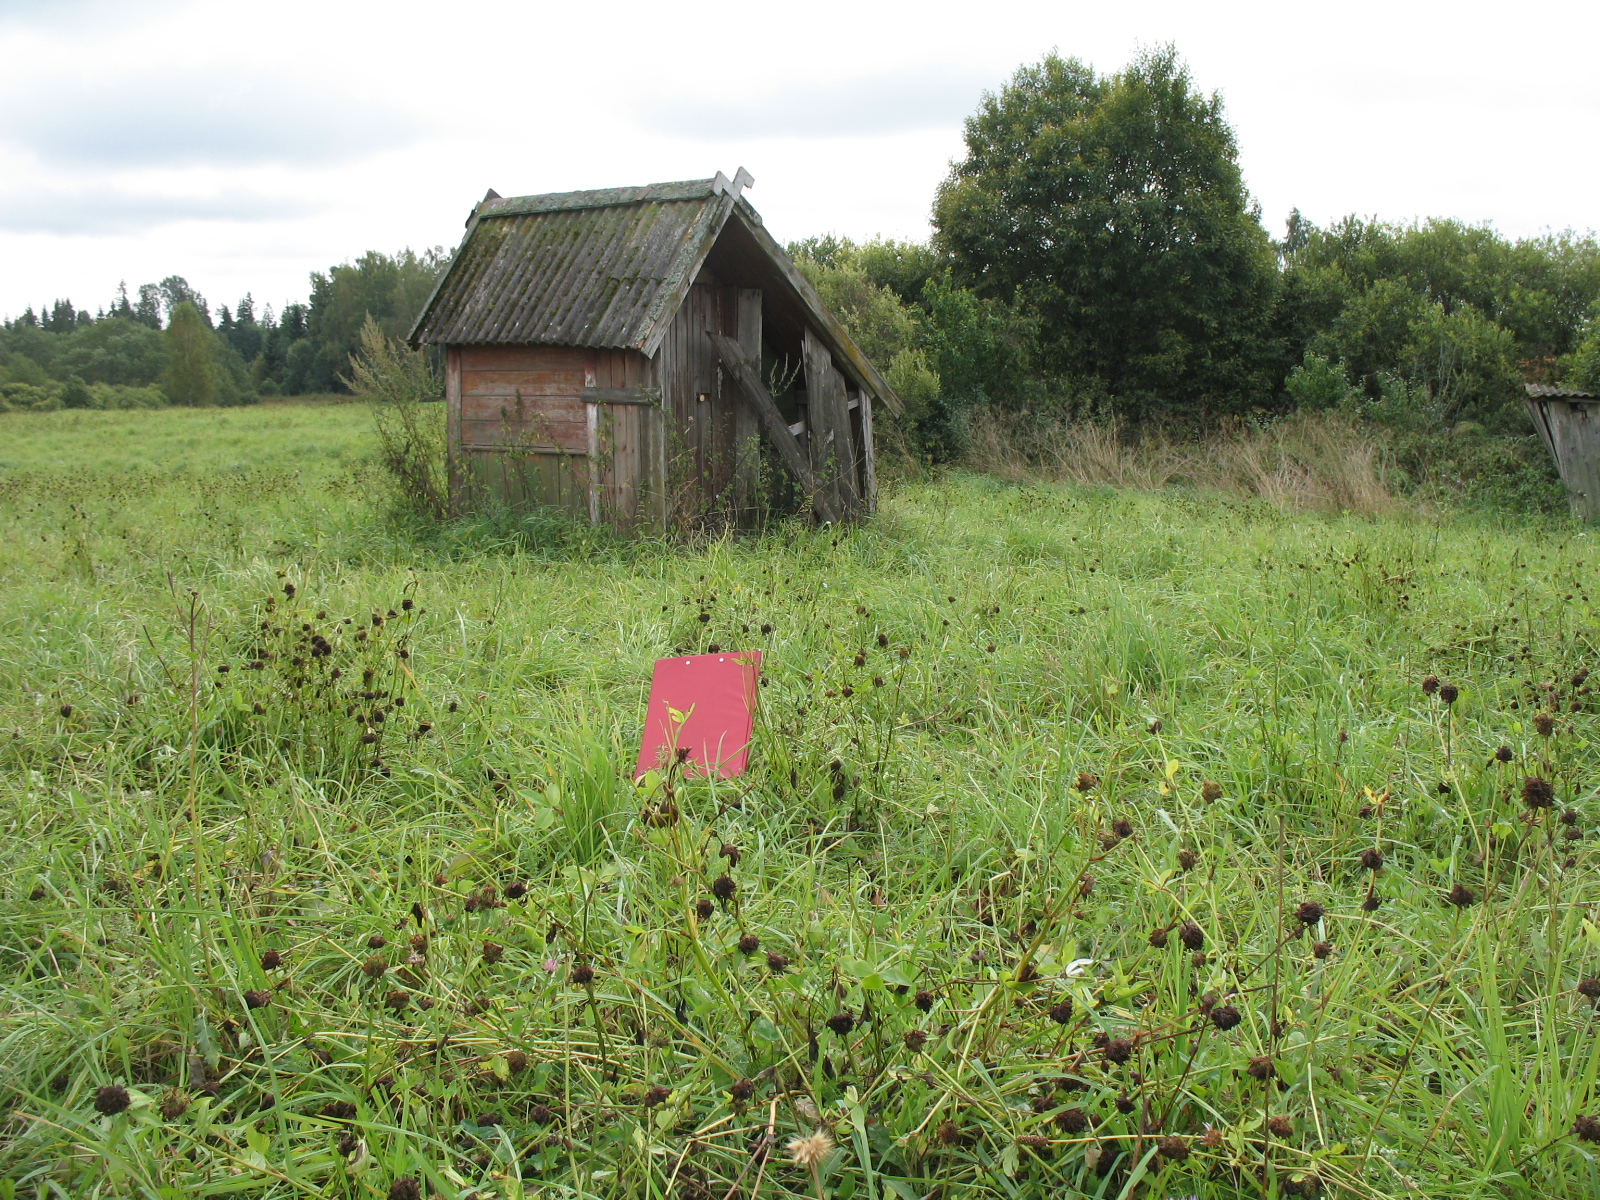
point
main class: Grassland
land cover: Grassland without tree/shrub cover
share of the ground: > 75 %
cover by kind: herbaceous plants 100 %
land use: Agriculture (excluding fallow land and kitchen gardens)
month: September
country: LV
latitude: 56.0419
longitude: 26.1106
